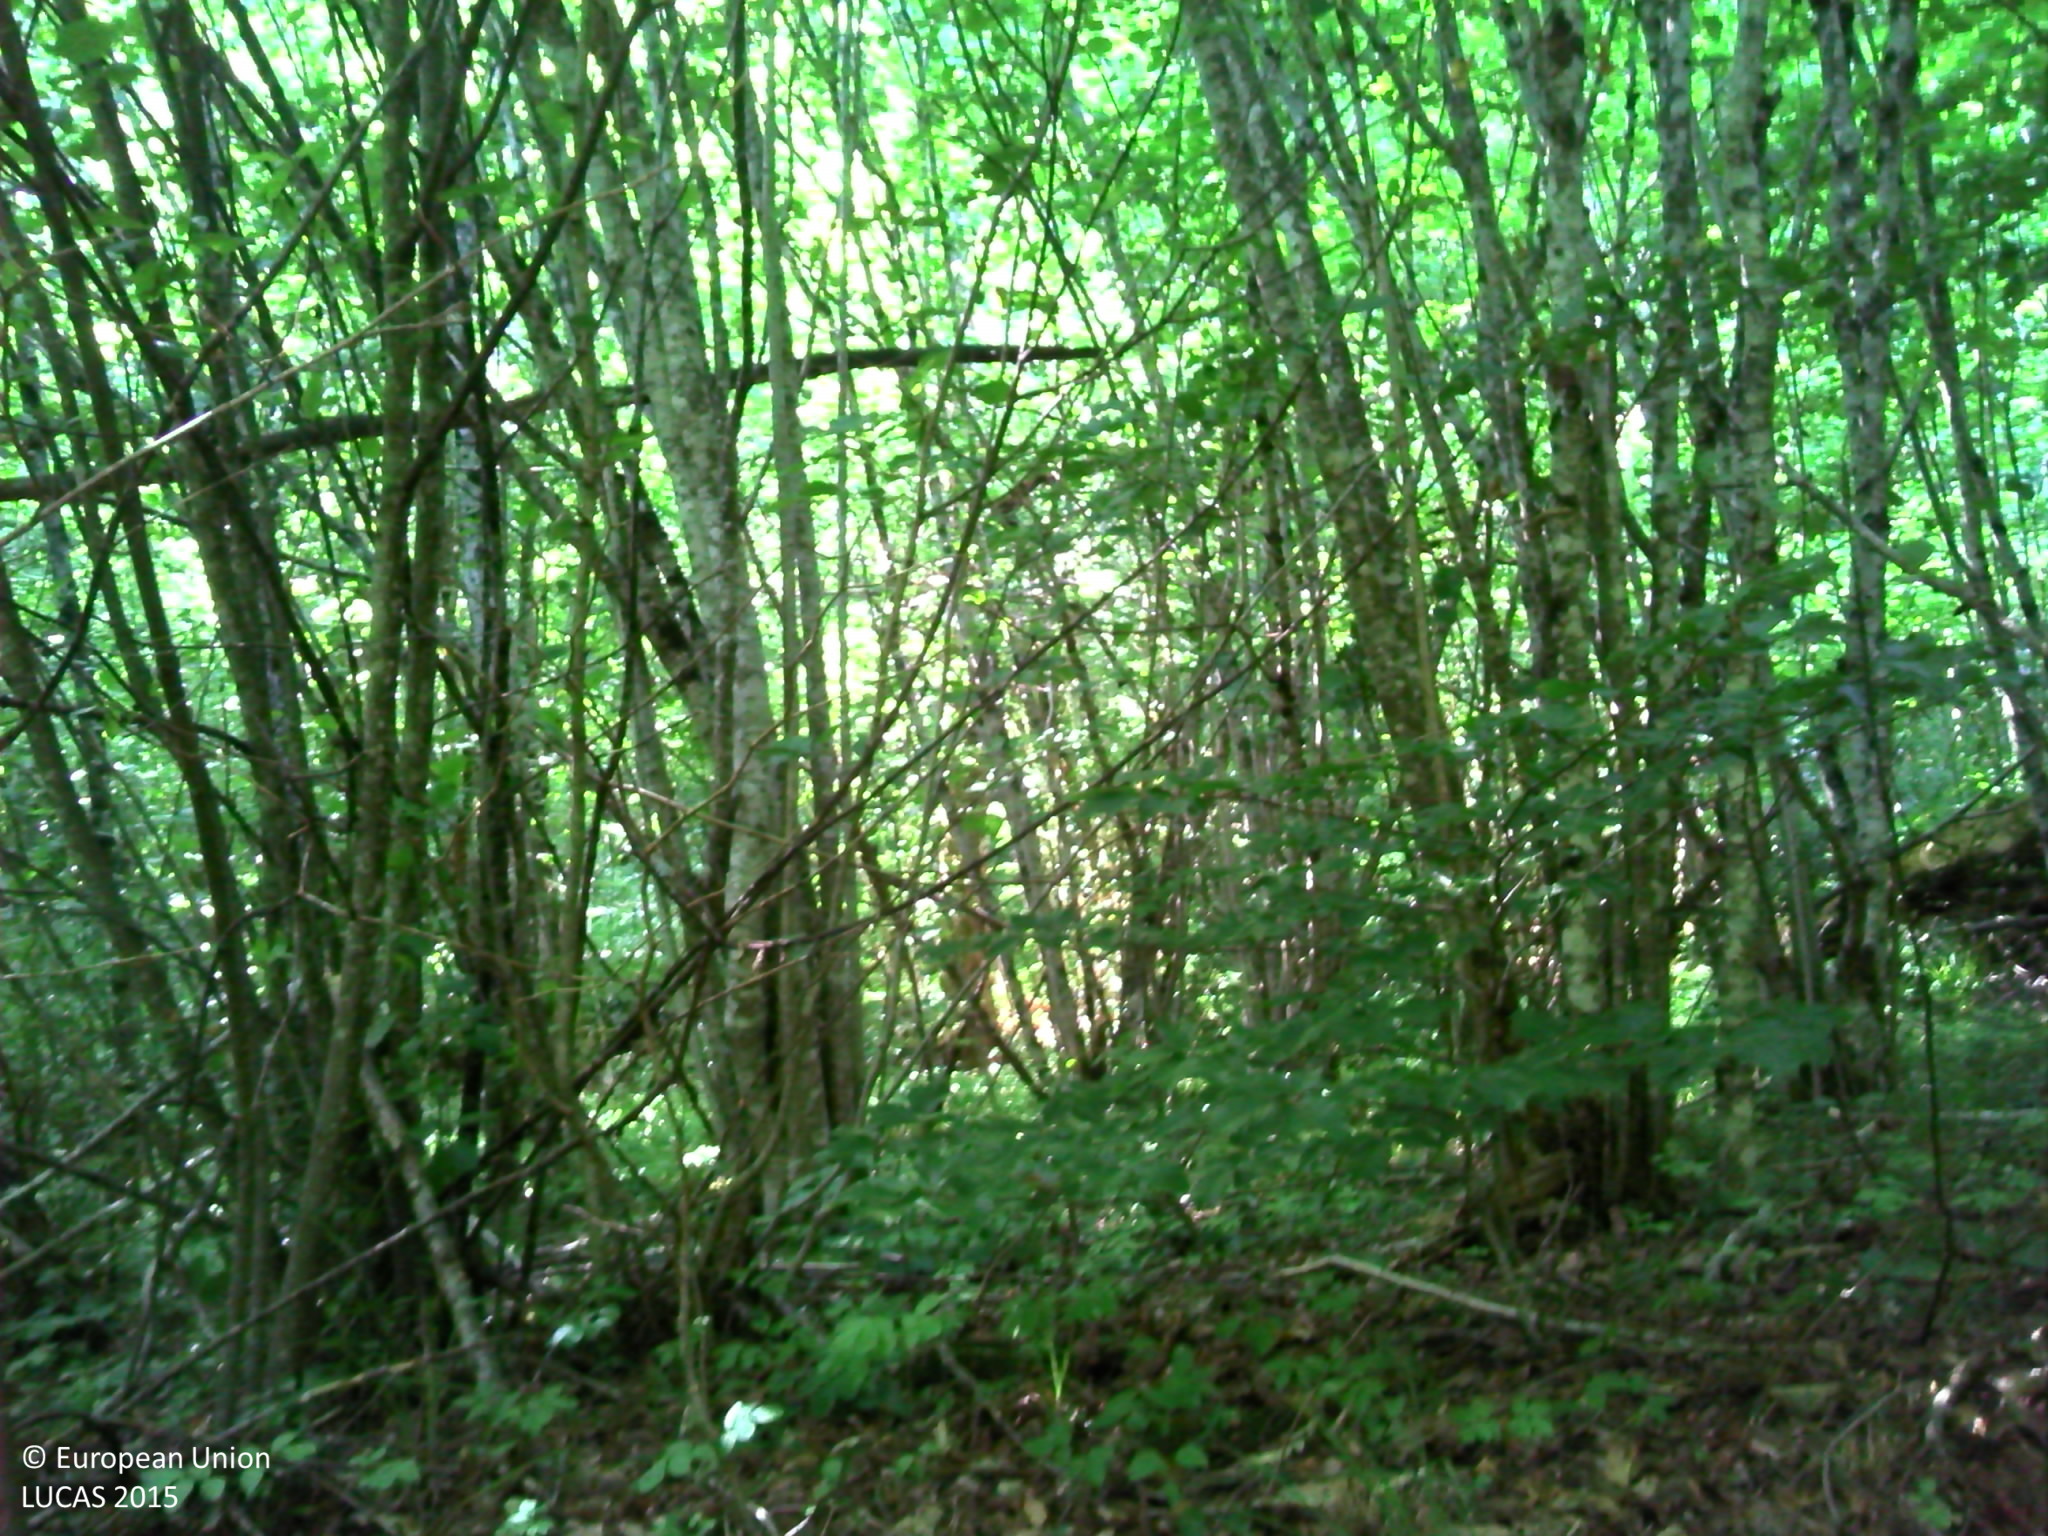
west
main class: Woodland
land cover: Broadleaved woodland
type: mesophytic deciduous forest
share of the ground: > 75 %
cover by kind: broadleaved forest trees 100 %
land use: Forestry
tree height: > 5 m
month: July
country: FR
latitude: 43.6321
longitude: 2.5823
